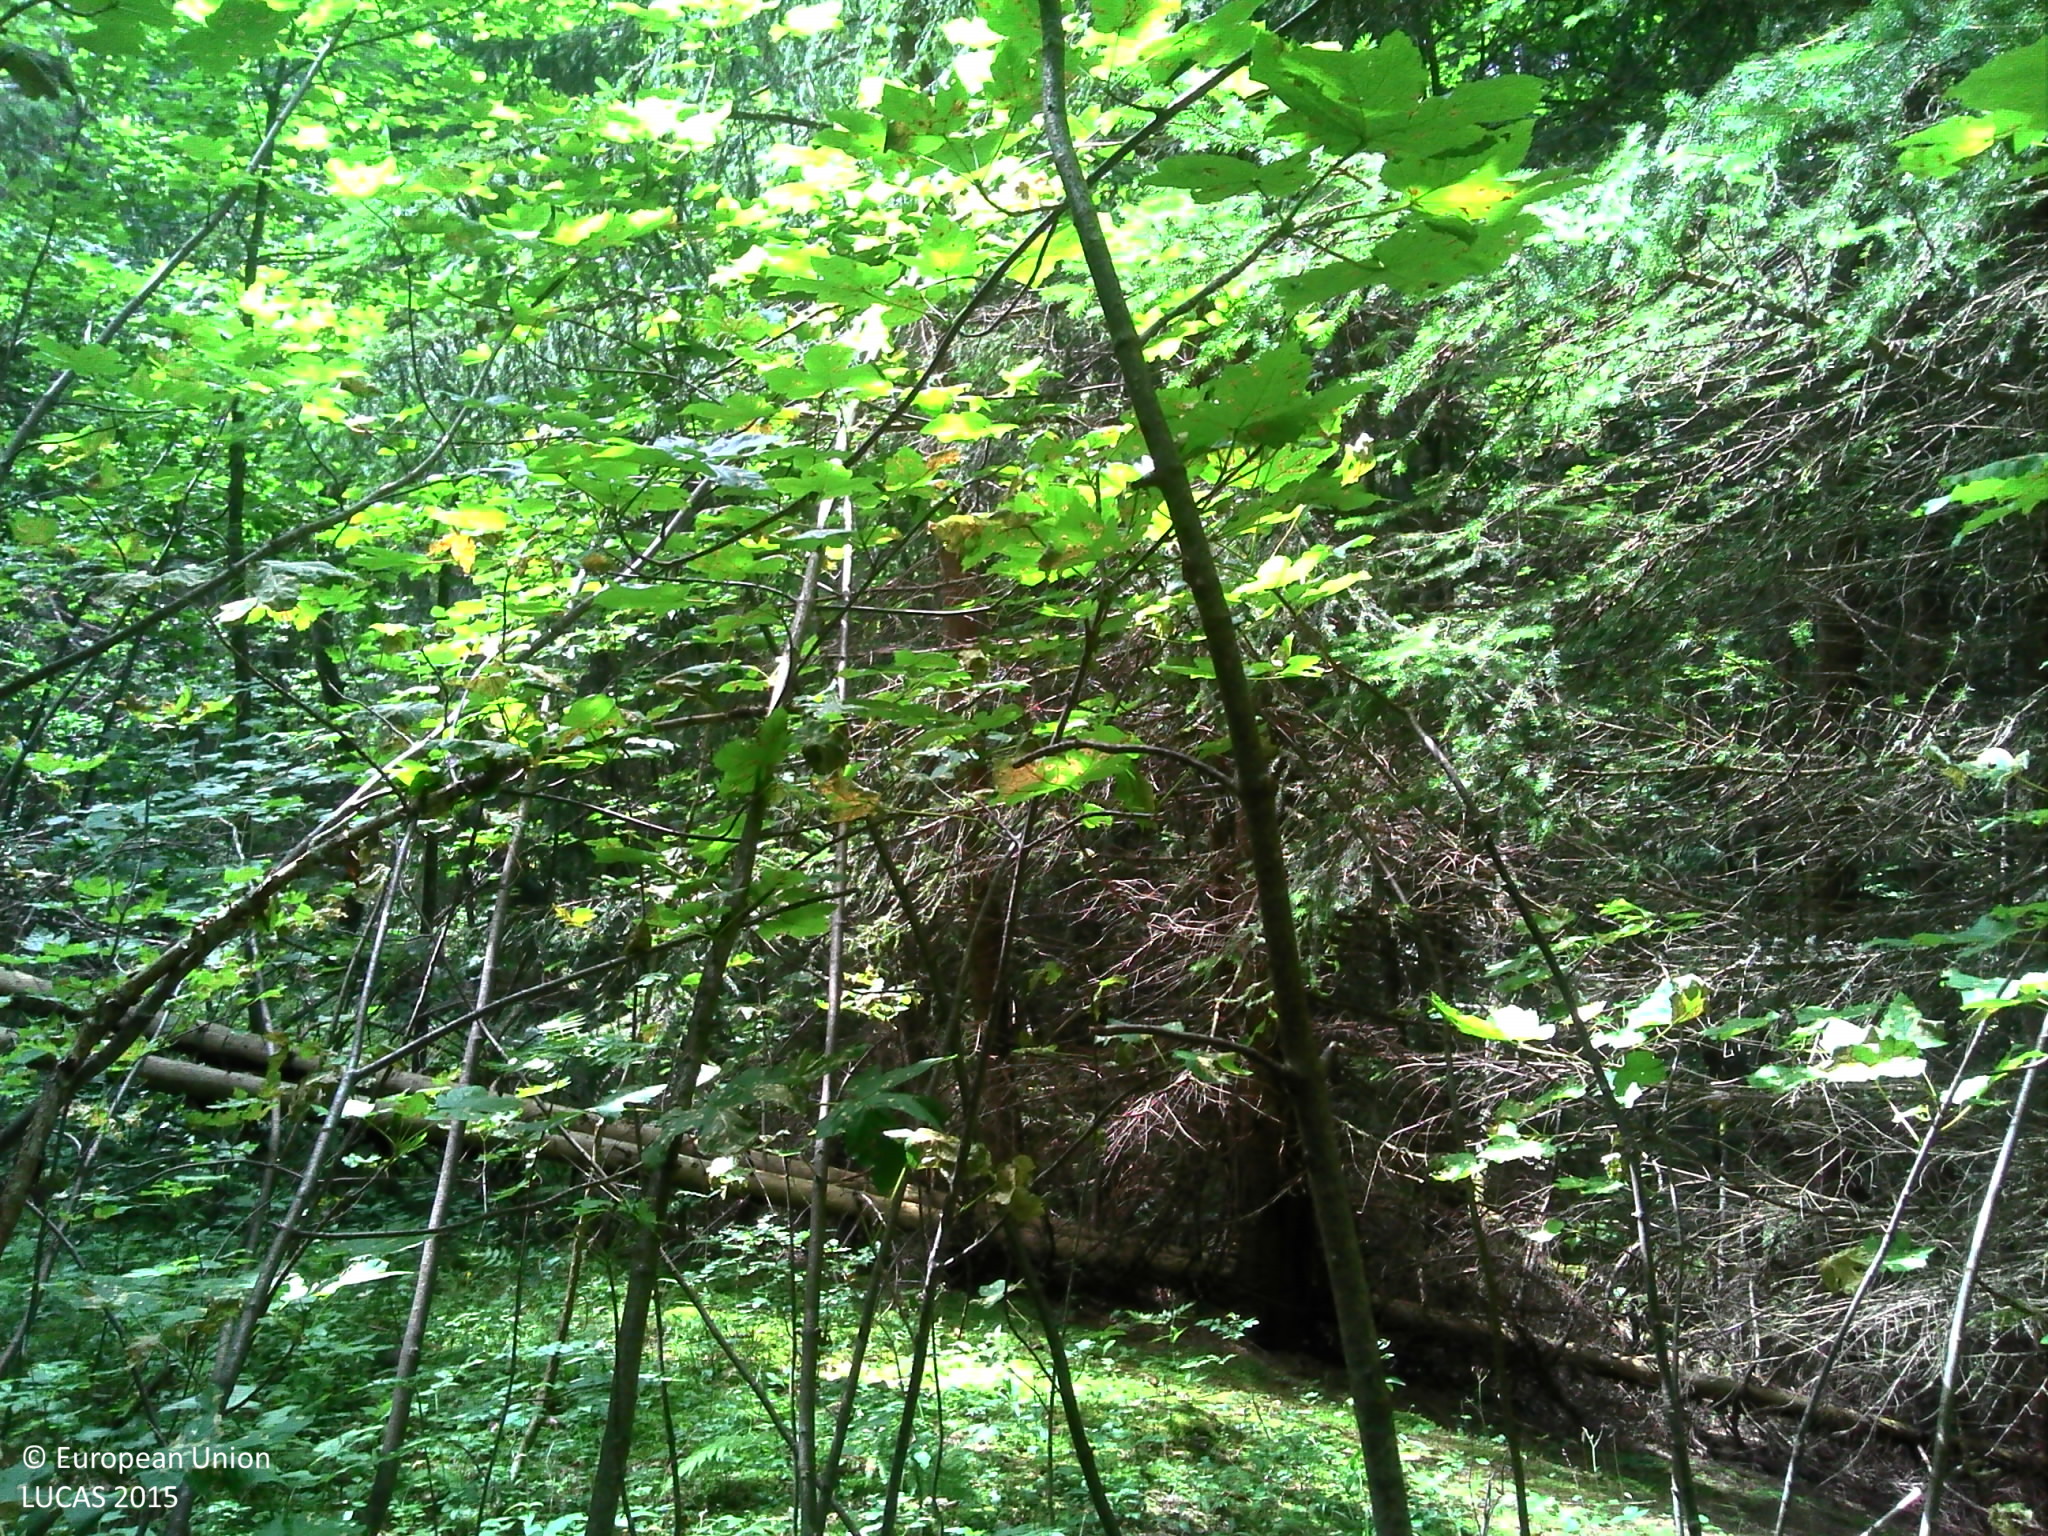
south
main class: Woodland
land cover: Spruce dominated coniferous woodland
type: alpine coniferous forest
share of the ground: > 75 %
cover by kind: coniferous forest trees 70 %, herbaceous plants 15 %, broadleaved forest trees 10 %, lichens and mosses 5 %
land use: Forestry
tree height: > 5 m
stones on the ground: < 10 %
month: July
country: FR
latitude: 45.9499
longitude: 6.4561
